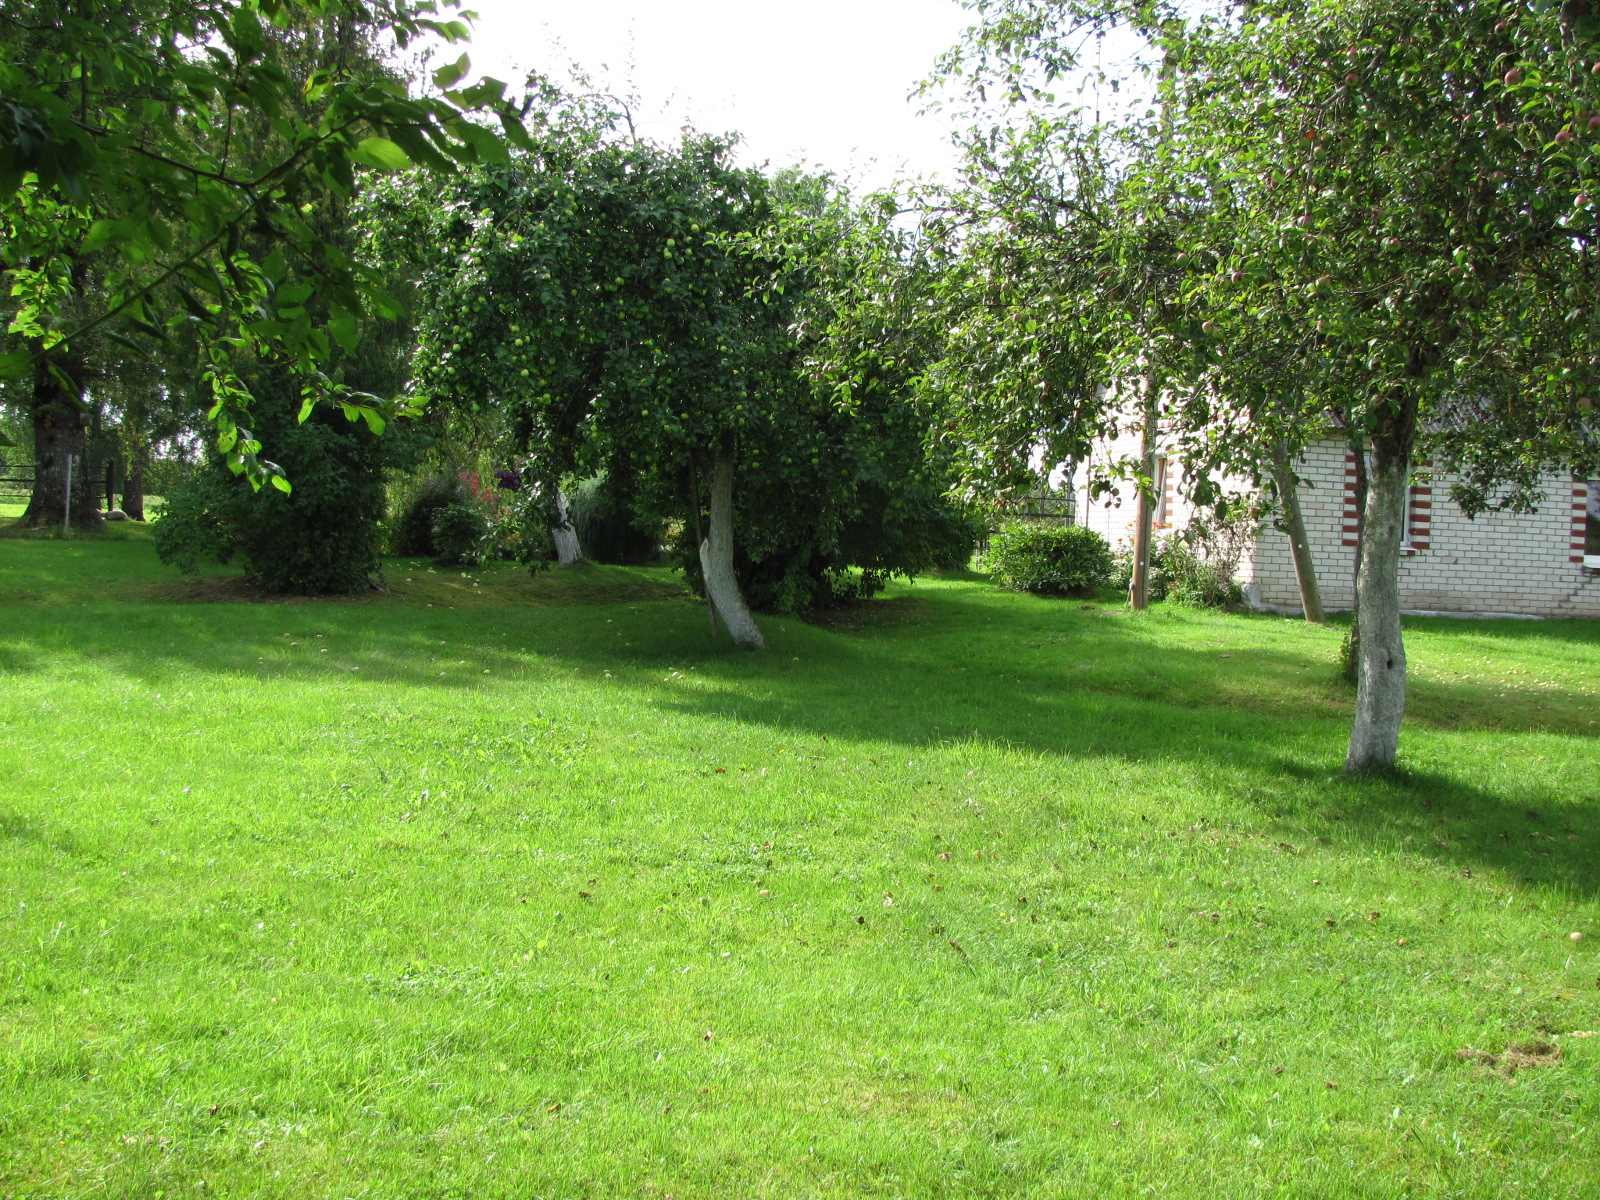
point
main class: Cropland
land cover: Apple fruit
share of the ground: 25 - 50 %
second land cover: Grassland without tree/shrub cover
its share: > 75 %
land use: Kitchen garden
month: August
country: LV
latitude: 56.8853
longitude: 25.2270
